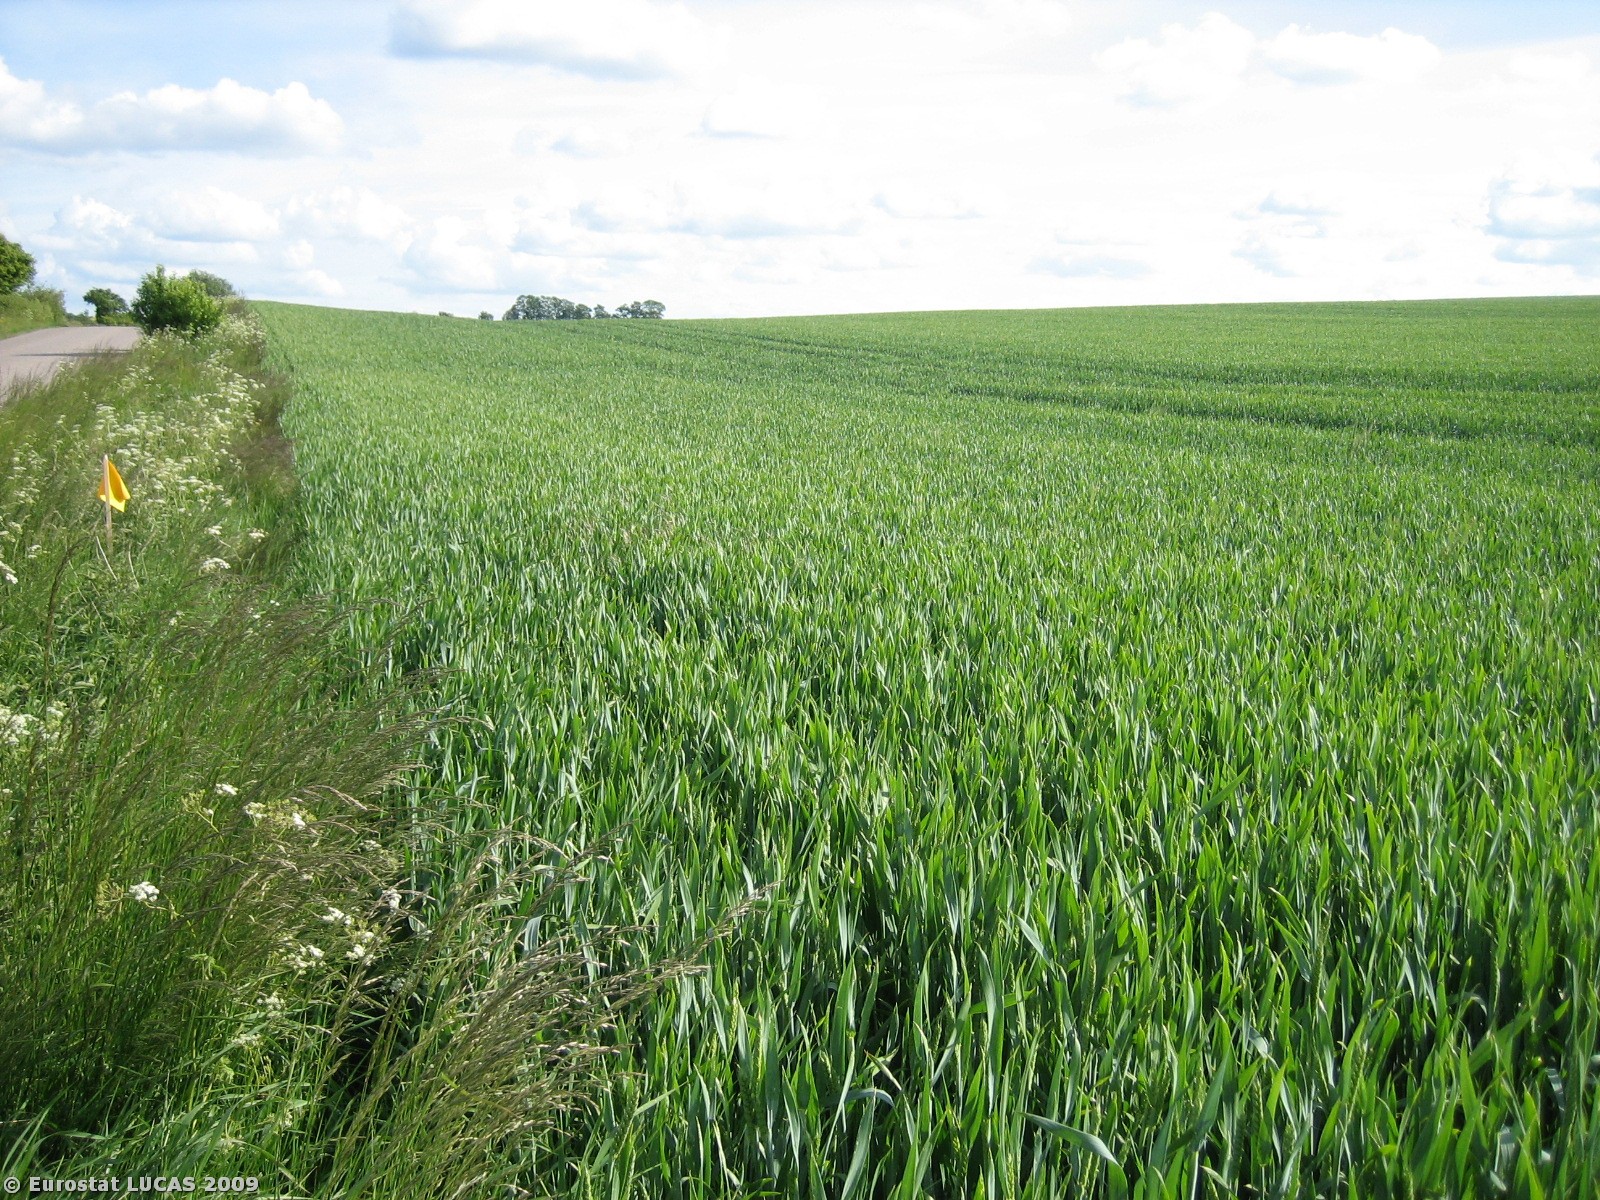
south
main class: Cropland
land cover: Common wheat
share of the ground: > 75 %
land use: Agriculture (excluding fallow land and kitchen gardens)
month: June
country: DK
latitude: 56.1515
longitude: 9.7267
